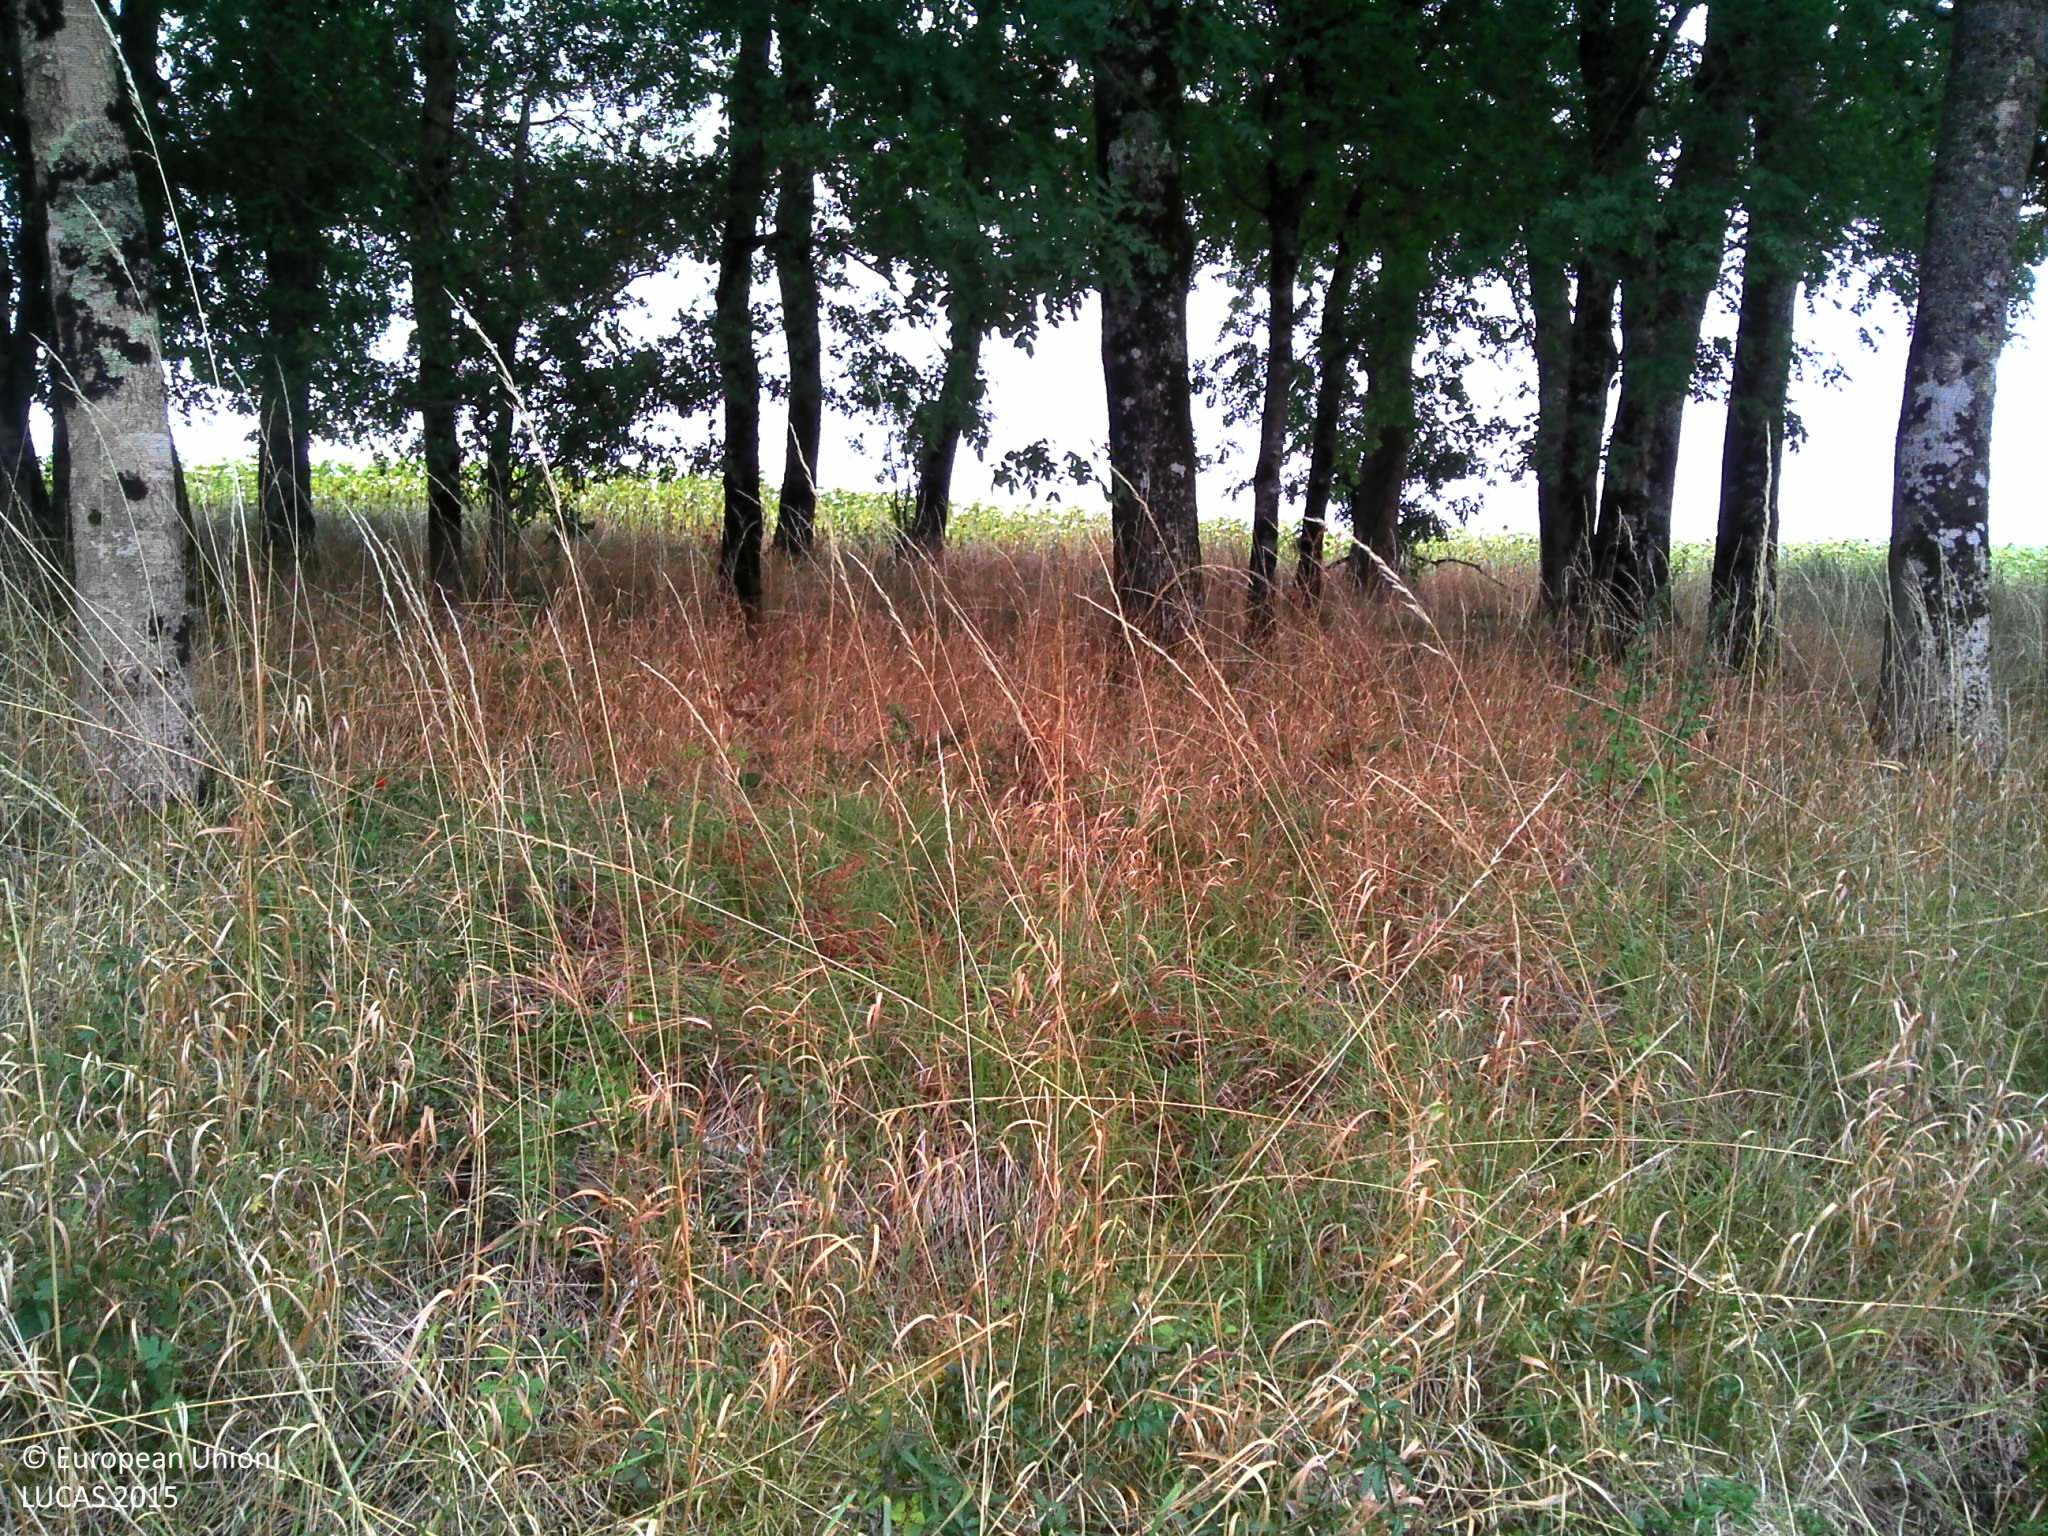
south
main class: Woodland
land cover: Broadleaved woodland
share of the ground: > 75 %
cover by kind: broadleaved forest trees 75 %, herbaceous plants 20 %, shrubs 5 %
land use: Semi-natural and natural areas not in use
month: August
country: FR
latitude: 44.2487
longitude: 0.5892
